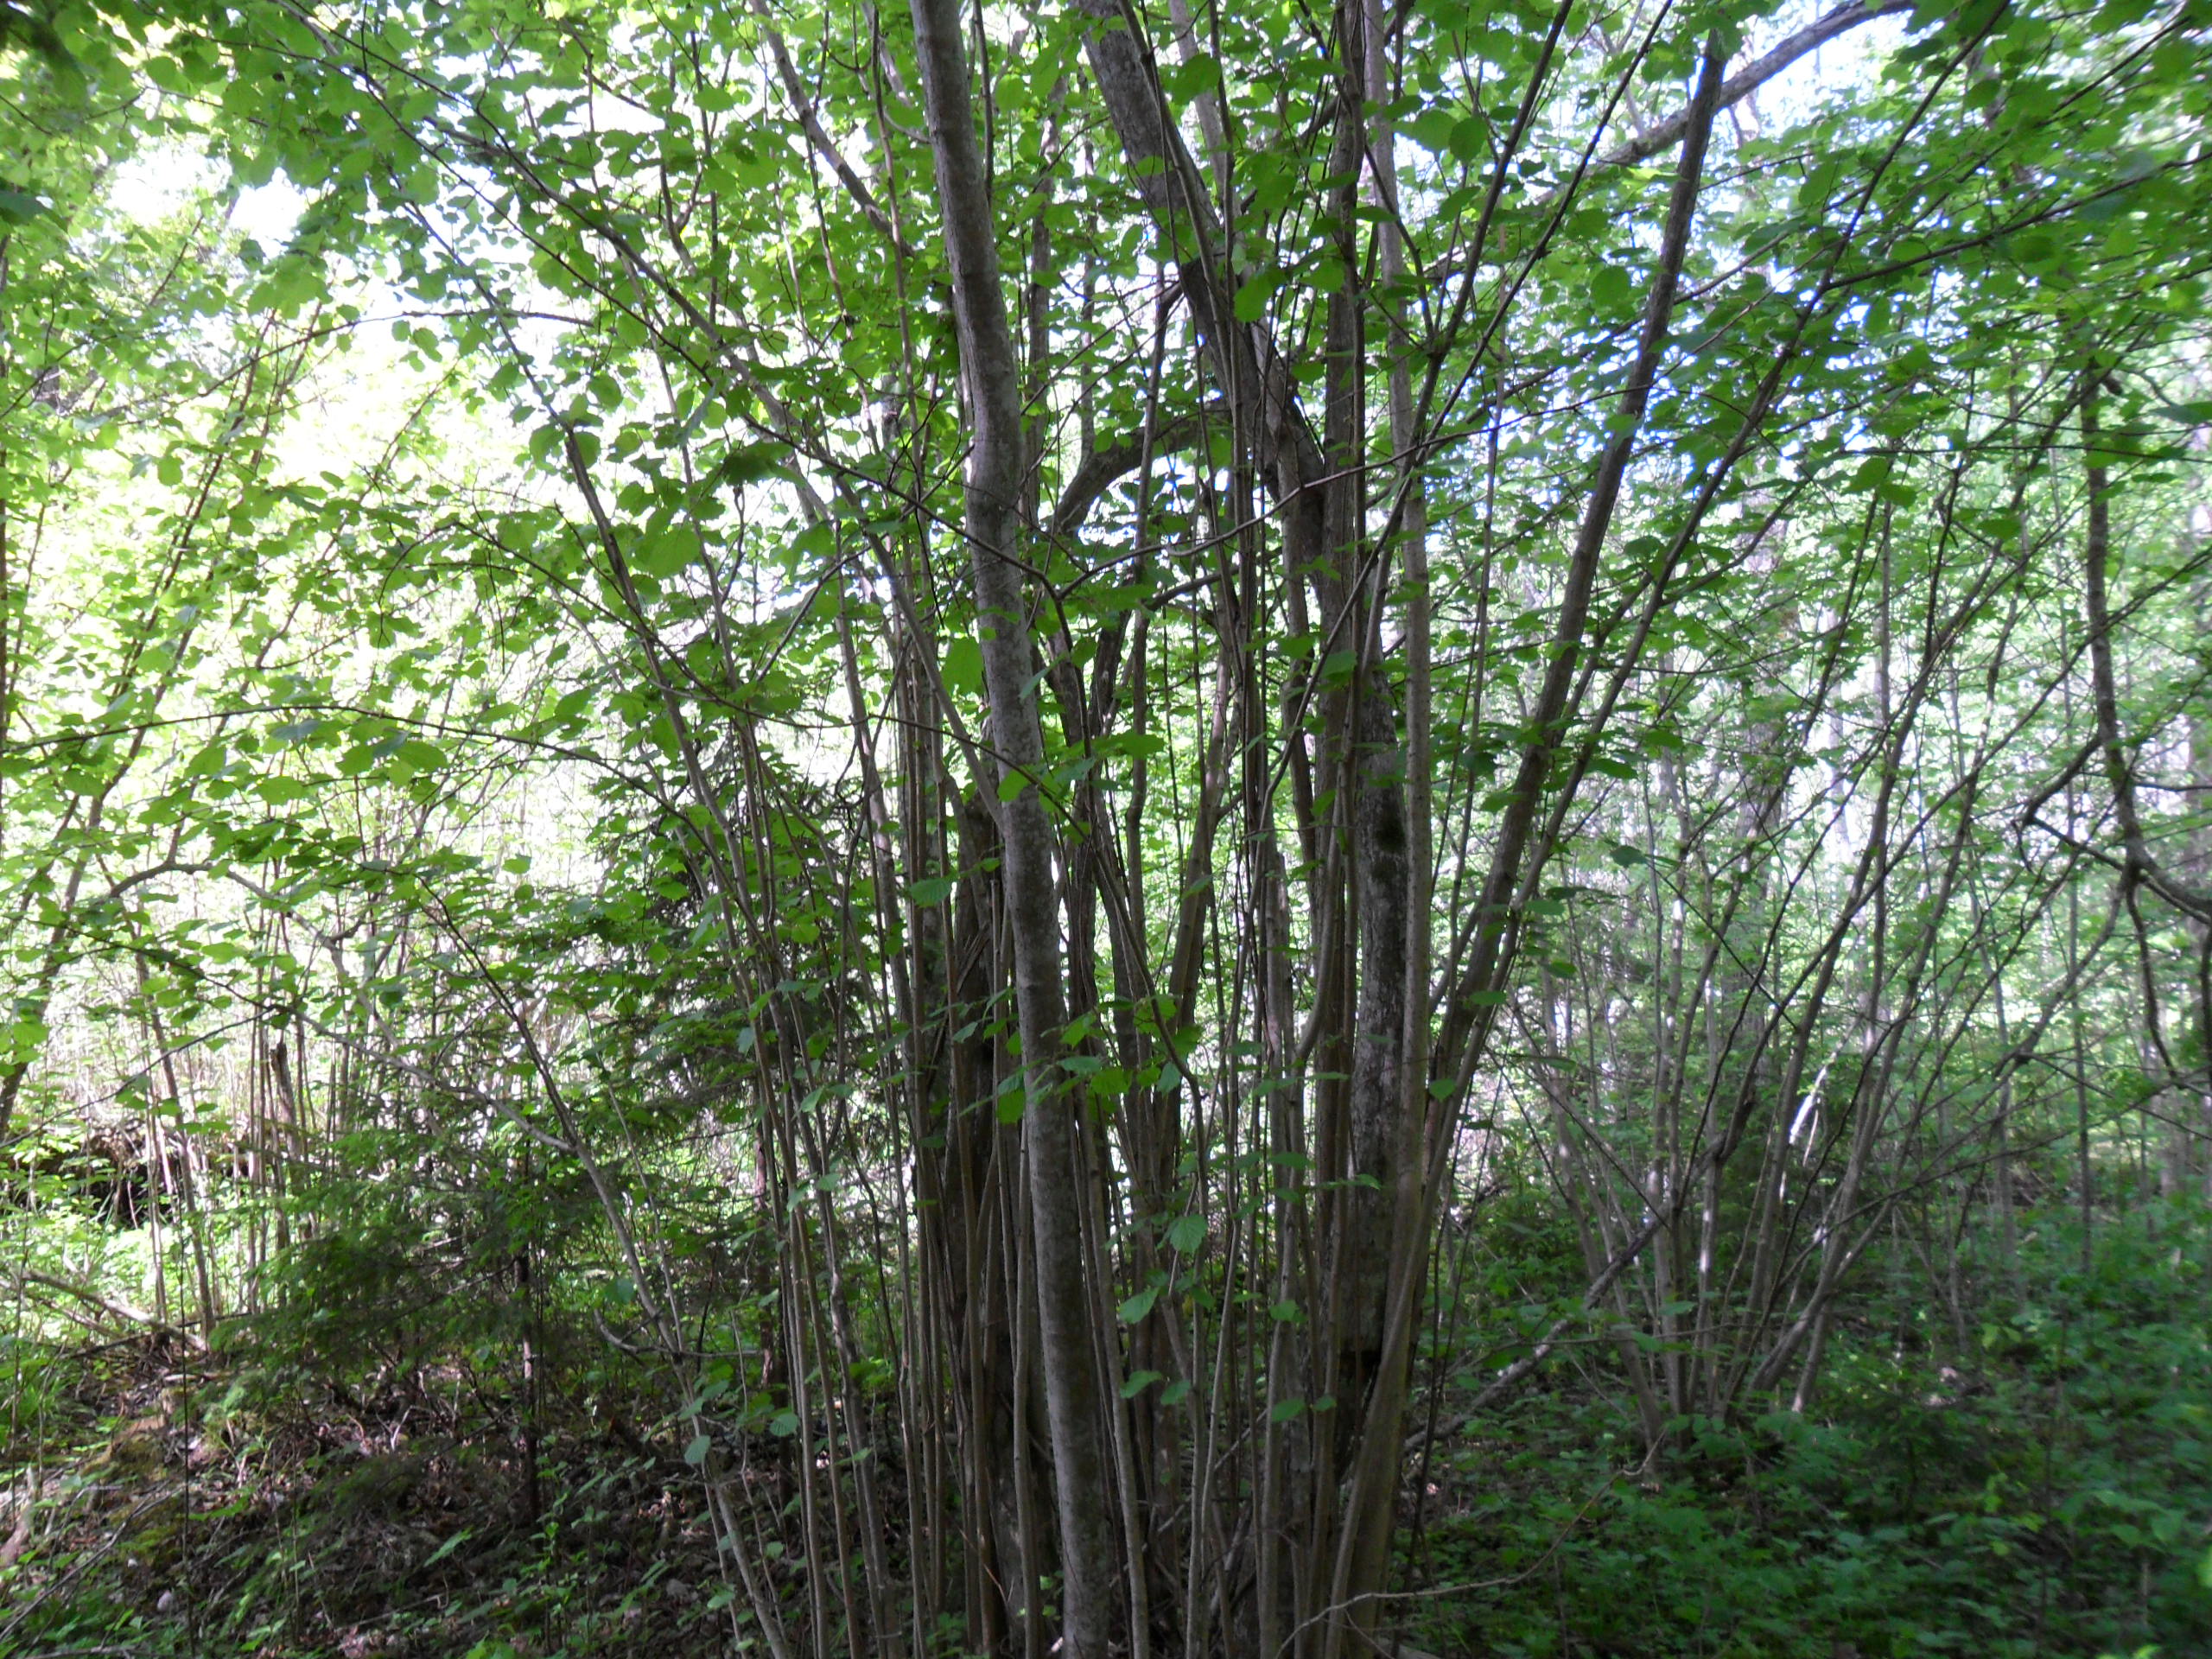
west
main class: Woodland
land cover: Broadleaved woodland
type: non-riverine alder, birch or aspen forest
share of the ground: > 75 %
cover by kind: broadleaved forest trees 70 %, coniferous forest trees 20 %, shrubs 5 %, herbaceous plants 5 %
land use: Forestry
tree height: > 5 m
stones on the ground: < 10 %
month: June
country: LV
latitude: 57.3882
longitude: 22.5818
